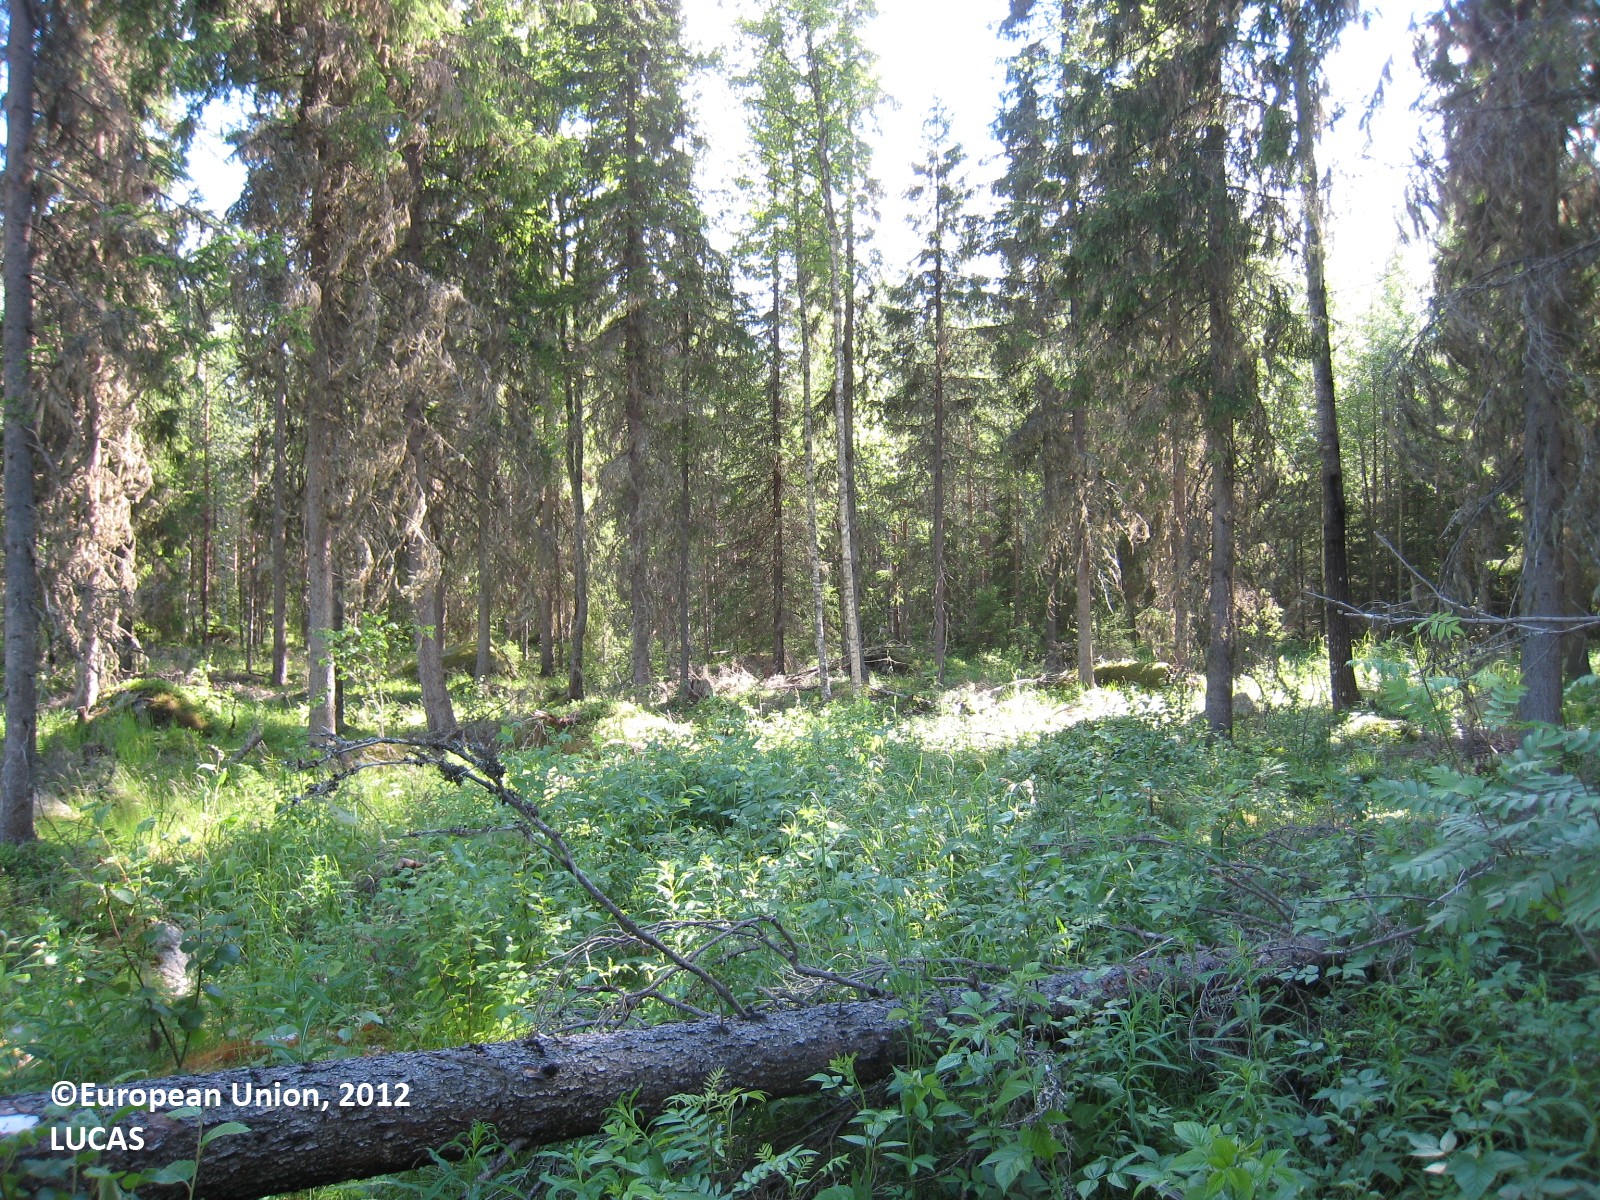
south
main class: Woodland
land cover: Spruce dominated coniferous woodland
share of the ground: 25 - 50 %
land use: Forestry
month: July
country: FI
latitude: 62.6036
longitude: 26.1194
